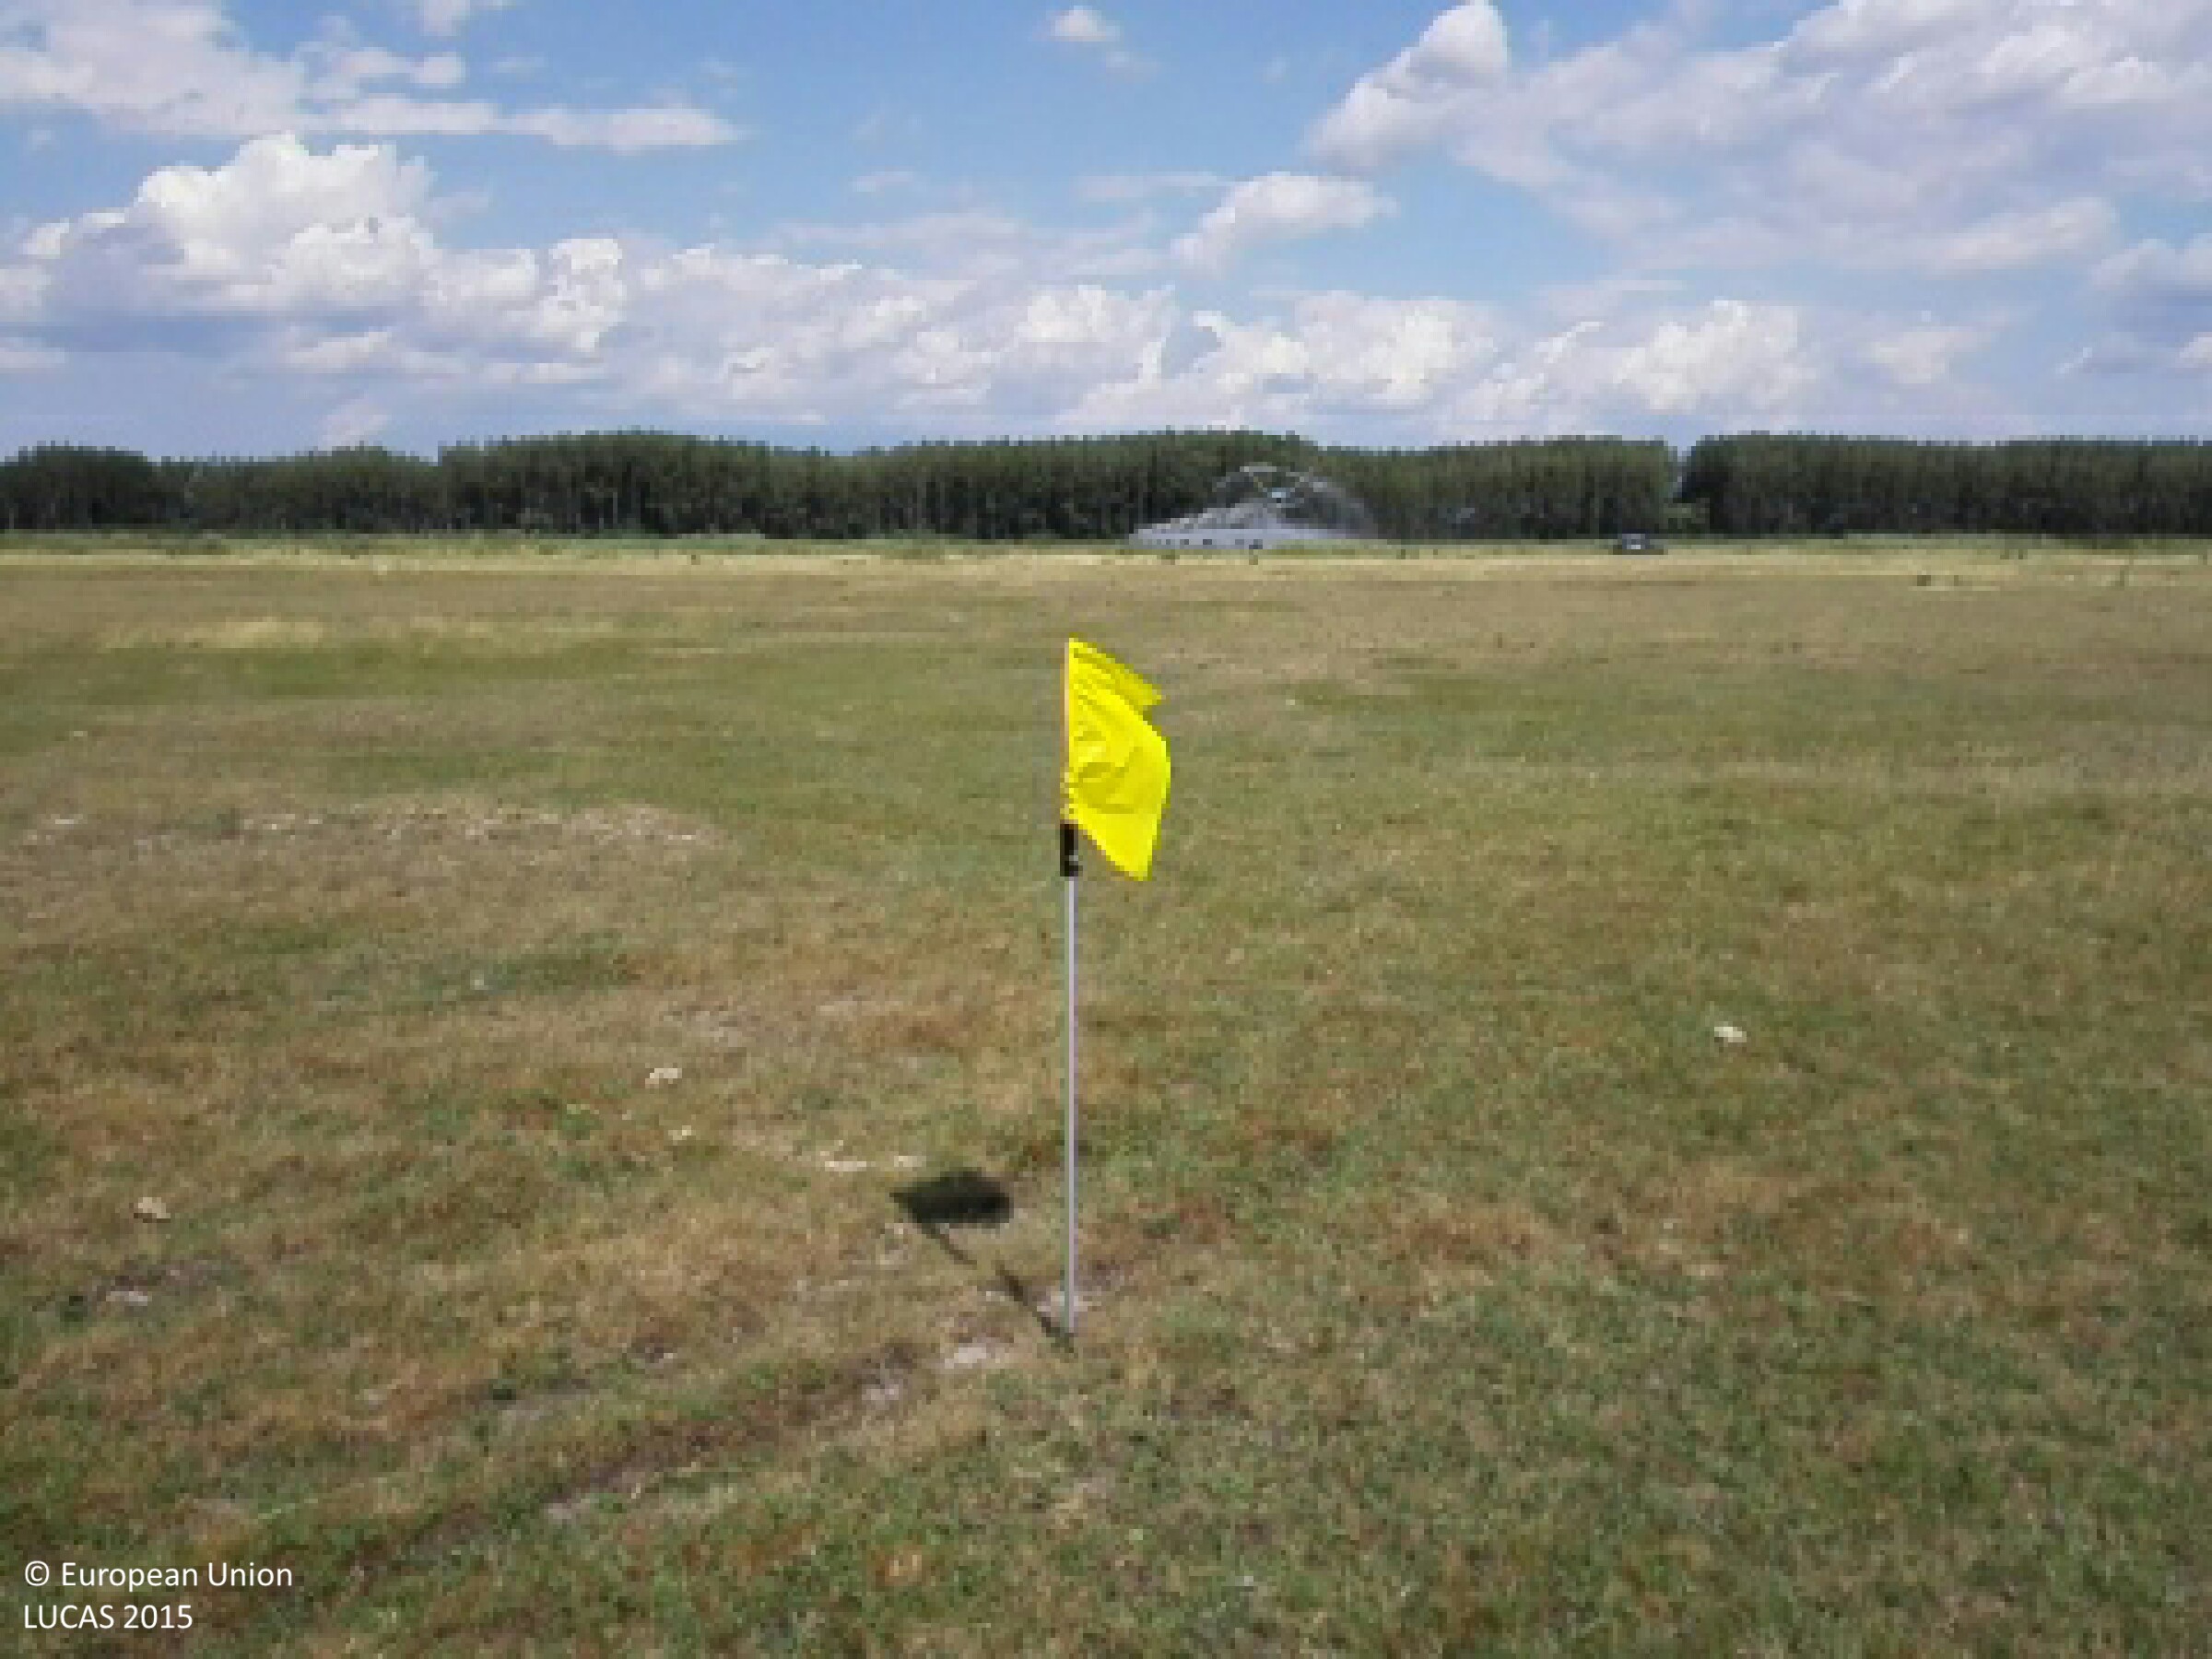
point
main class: Grassland
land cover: Grassland without tree/shrub cover
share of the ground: > 75 %
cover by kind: herbaceous plants 100 %
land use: Agriculture (excluding fallow land and kitchen gardens)
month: July
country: HU
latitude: 47.5119
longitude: 21.3137
